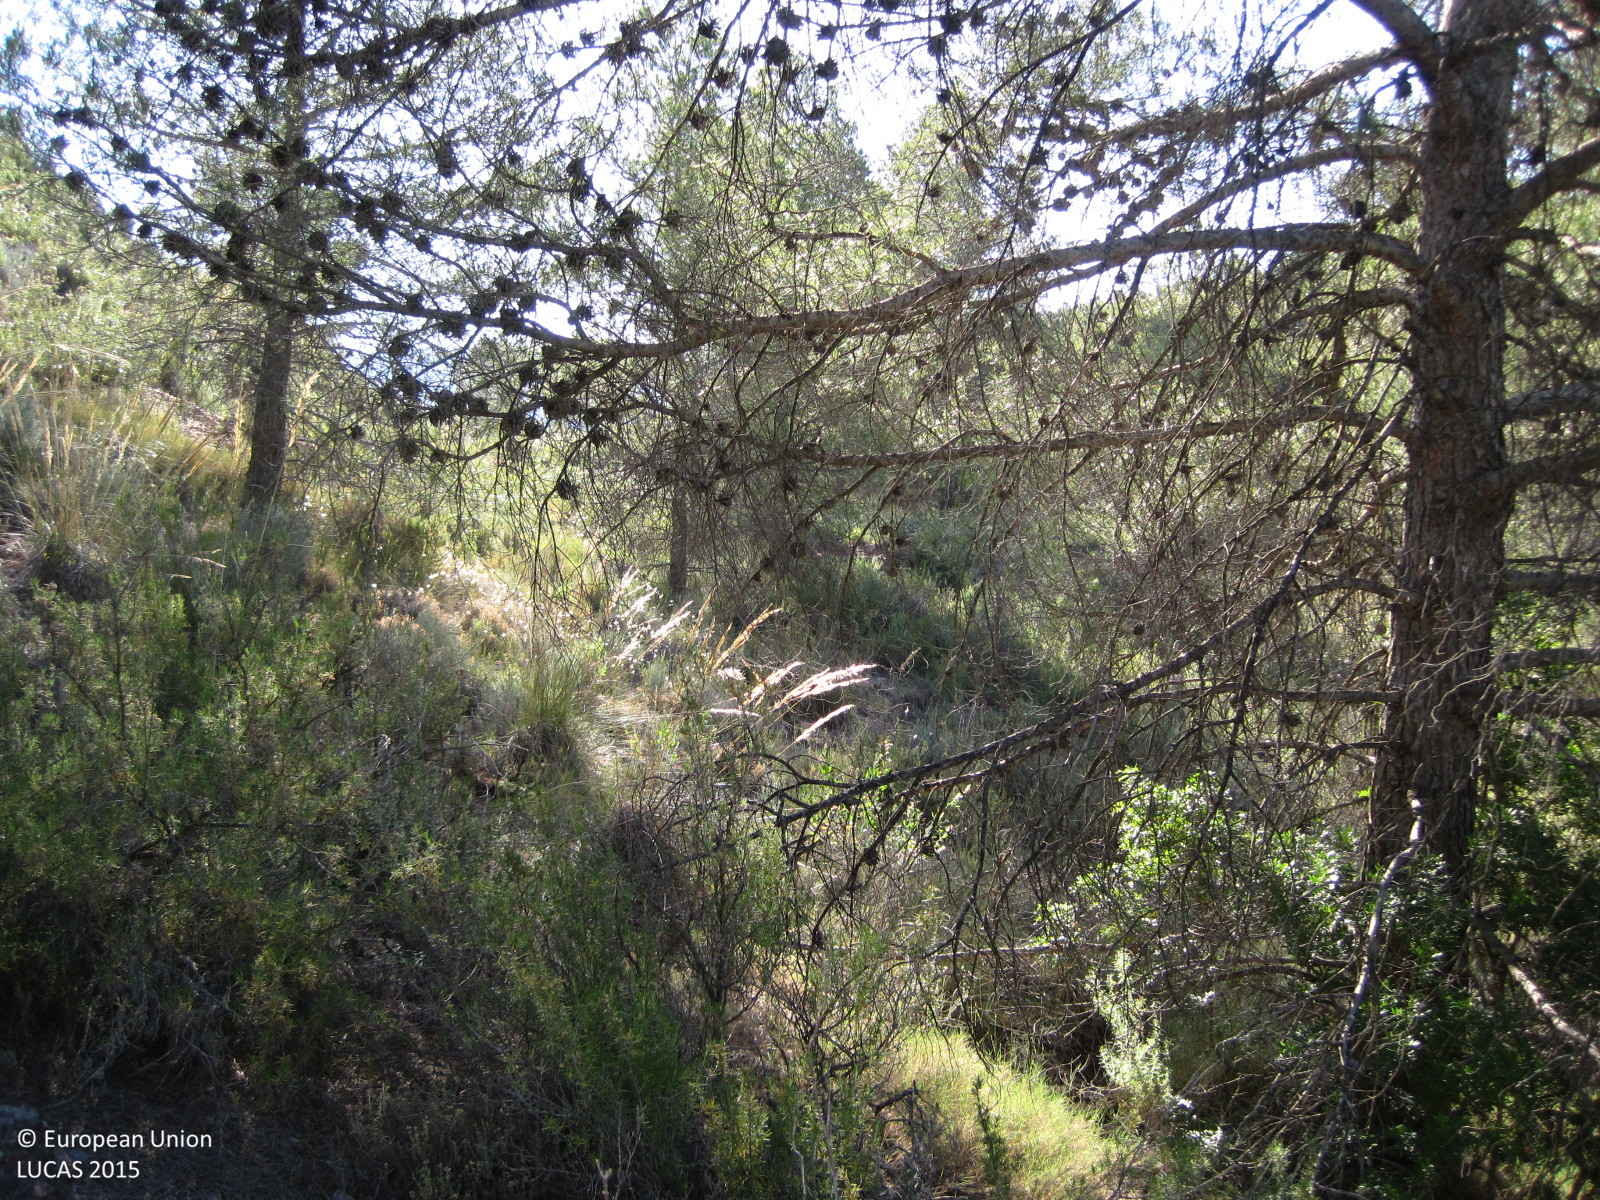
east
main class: Woodland
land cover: Pine dominated coniferous woodland
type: coniferous forest of the mediterranean region
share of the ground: 10 - 25 %
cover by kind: shrubs 30 %, herbaceous plants 25 %, unconsolidated bare surface 25 %, coniferous forest trees 20 %
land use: Forestry
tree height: > 5 m
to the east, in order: Pine dominated coniferous woodland; Dry stone walls; Shrubland with sparse tree cover; Vineyards
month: June
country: ES
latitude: 39.2766
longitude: -1.0457
